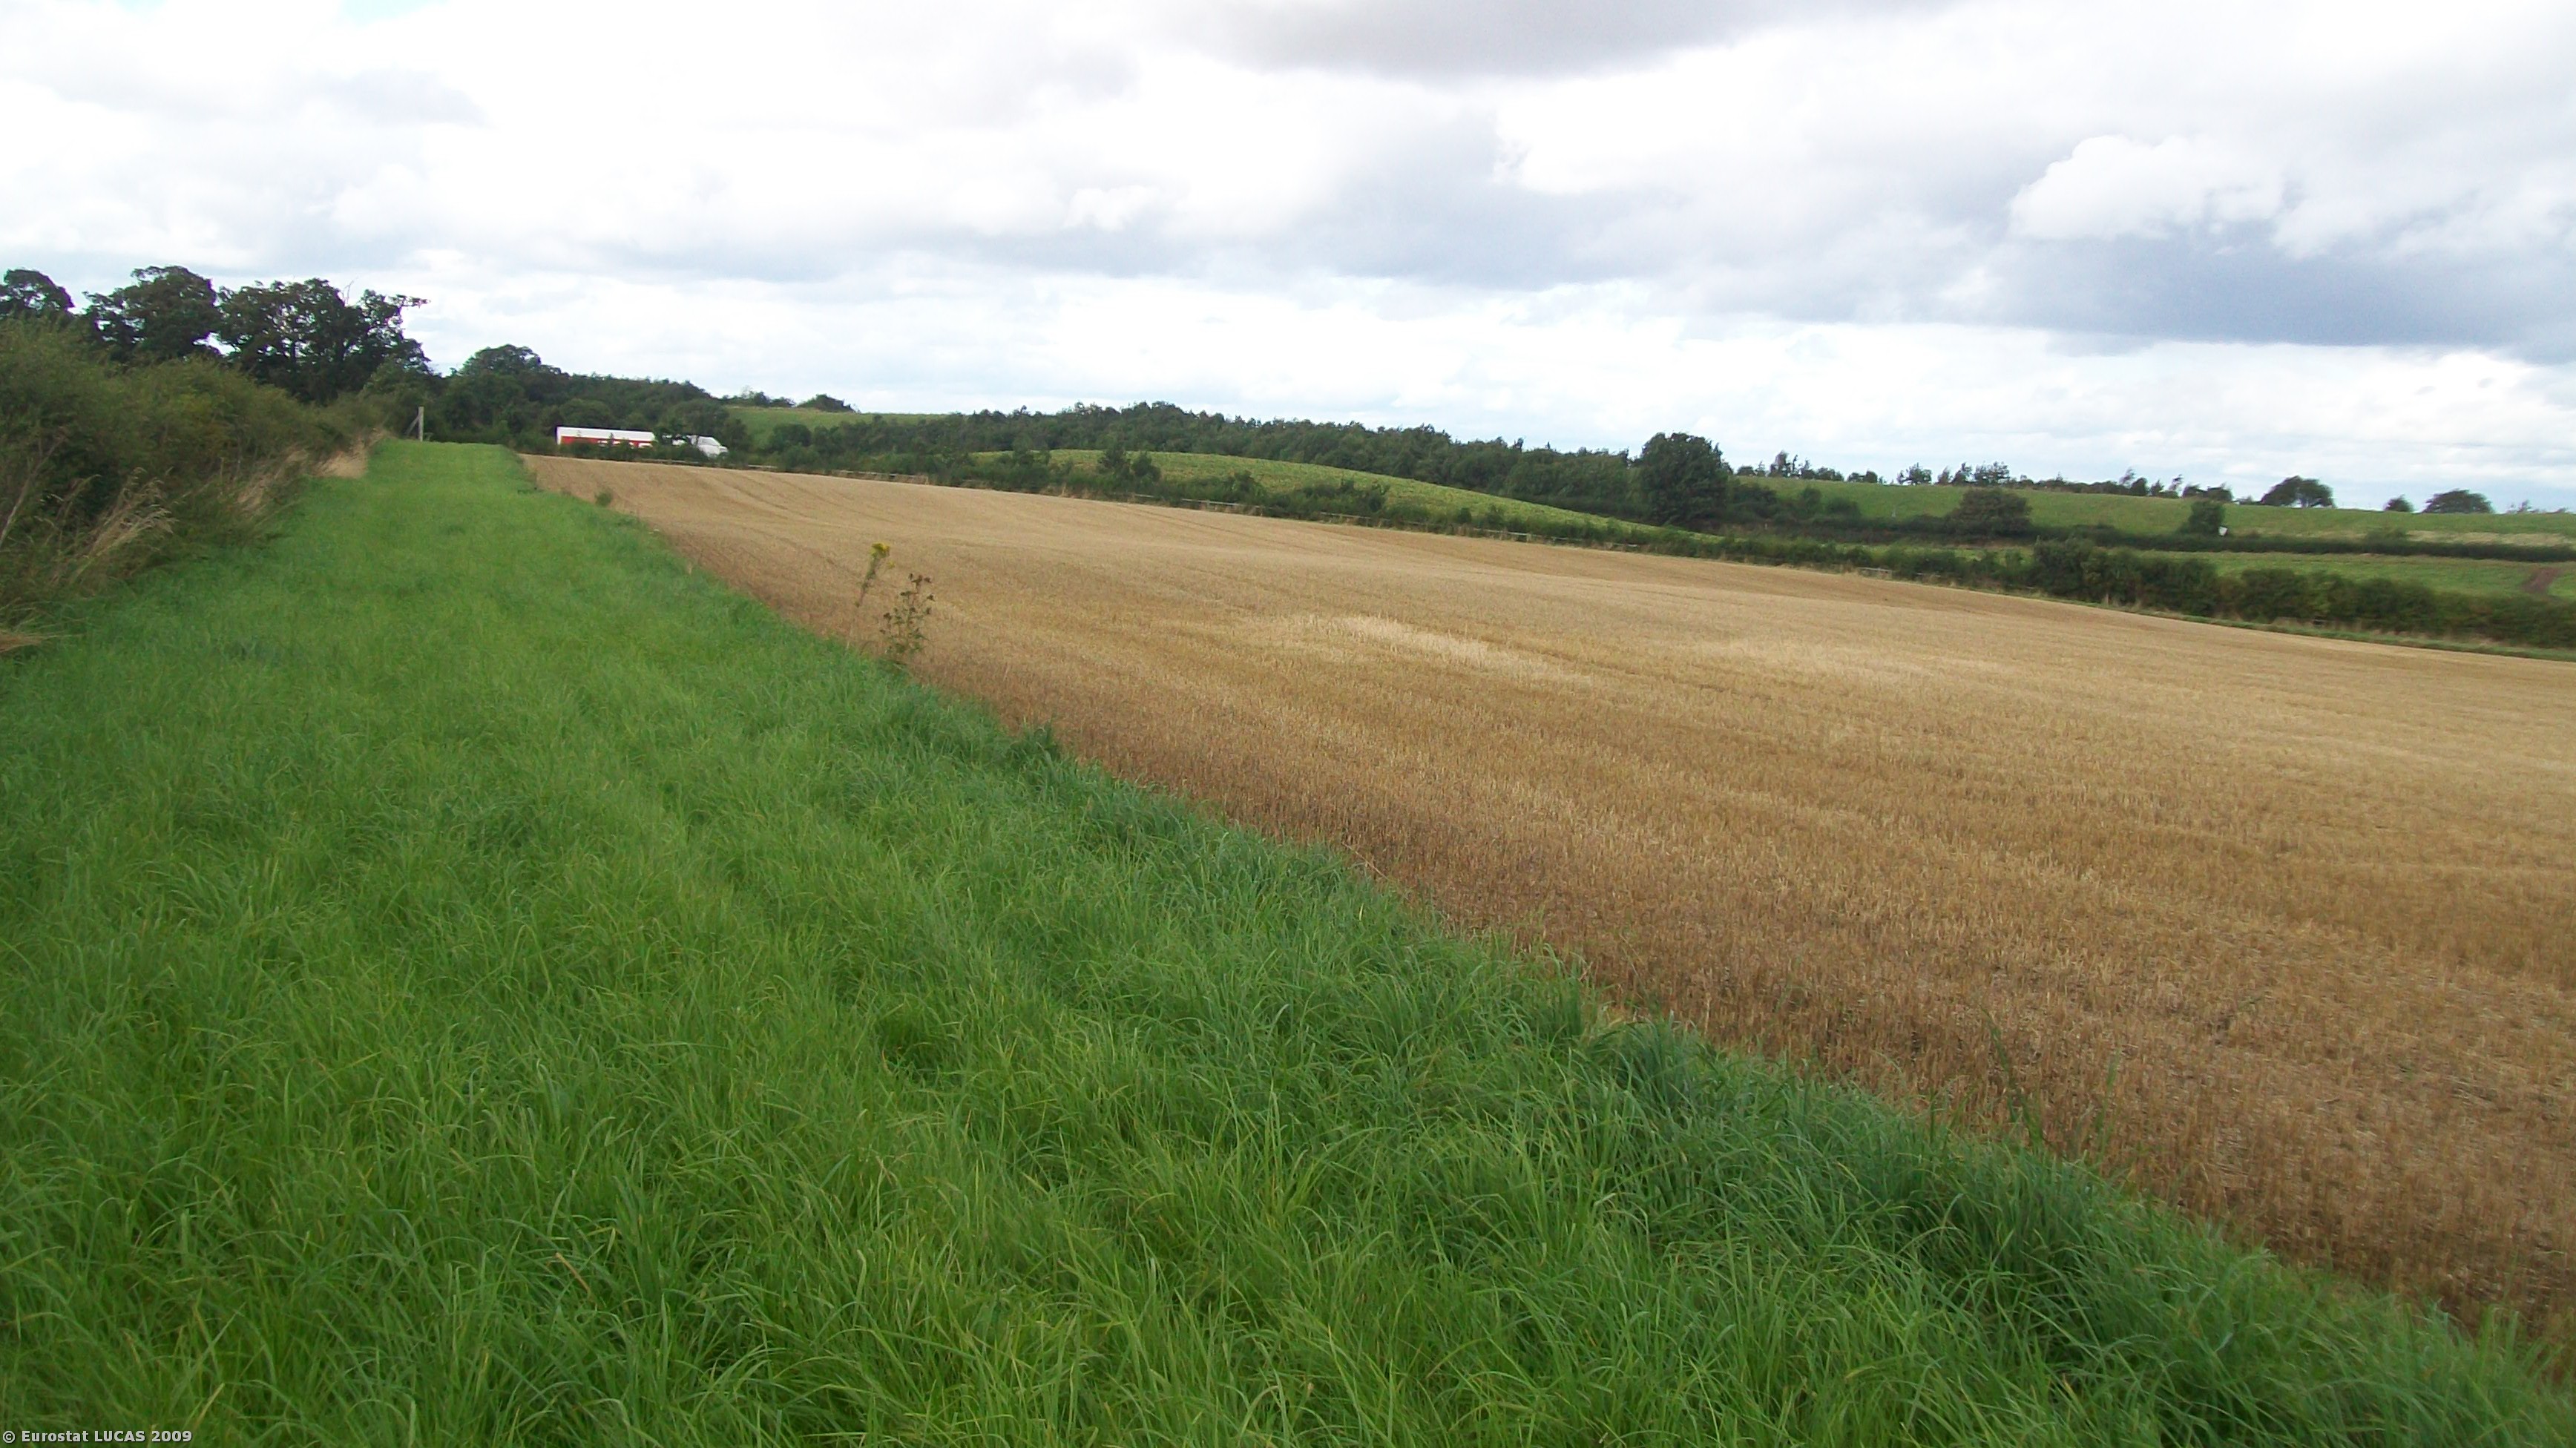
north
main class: Grassland
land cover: Grassland without tree/shrub cover
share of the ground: > 75 %
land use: Agriculture (excluding fallow land and kitchen gardens)
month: September
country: GB
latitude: 52.6892
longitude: -2.5686
